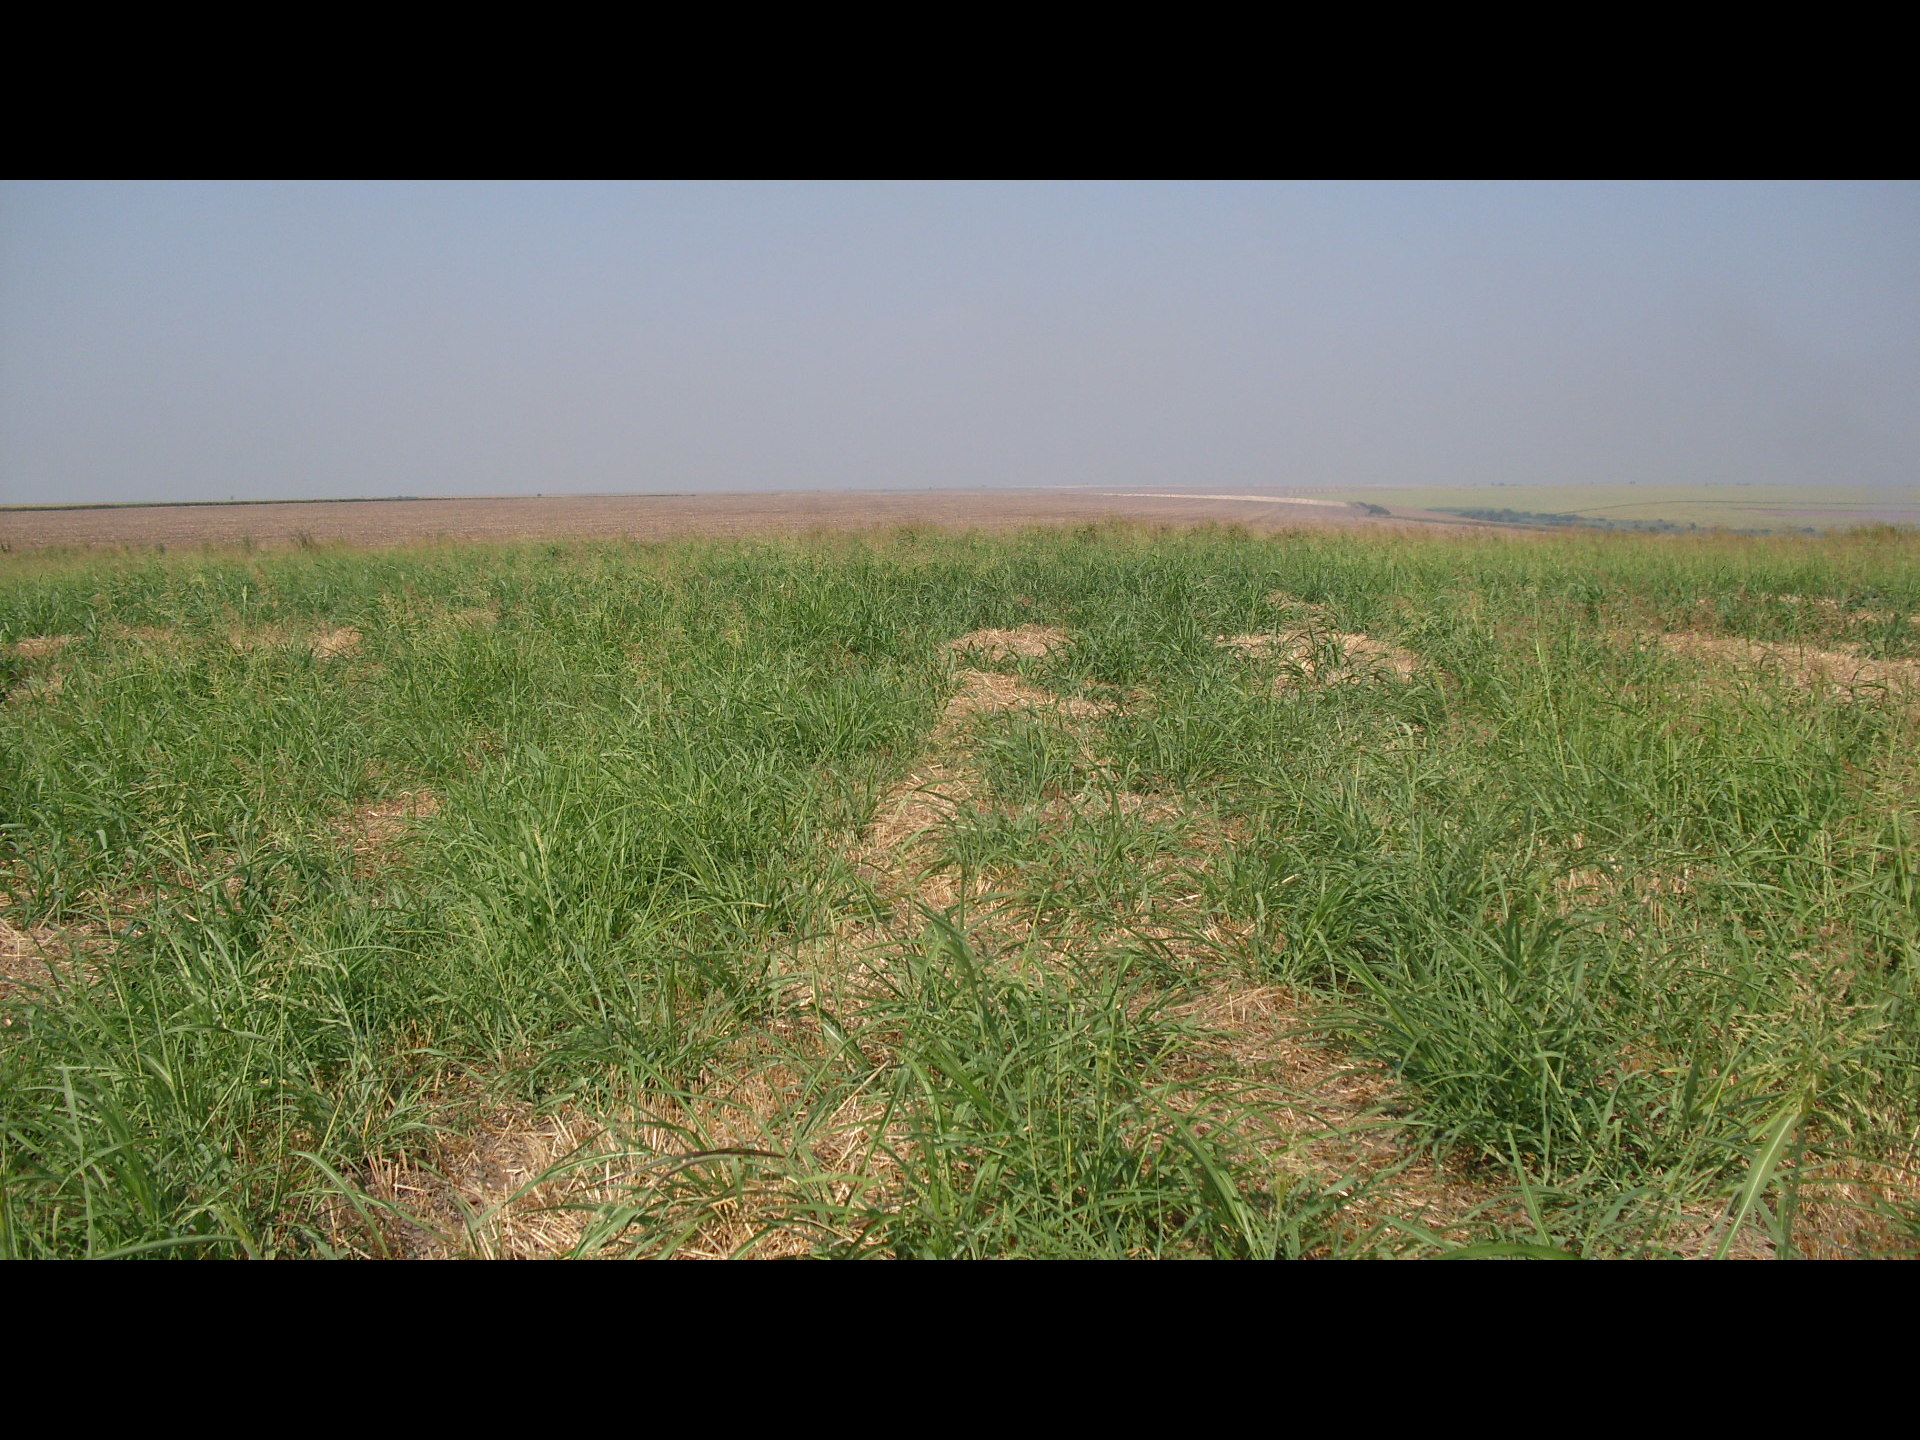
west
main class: Cropland
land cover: Barley
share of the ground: > 75 %
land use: Agriculture (excluding fallow land and kitchen gardens)
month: July
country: BG
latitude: 43.7289
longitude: 23.5671
